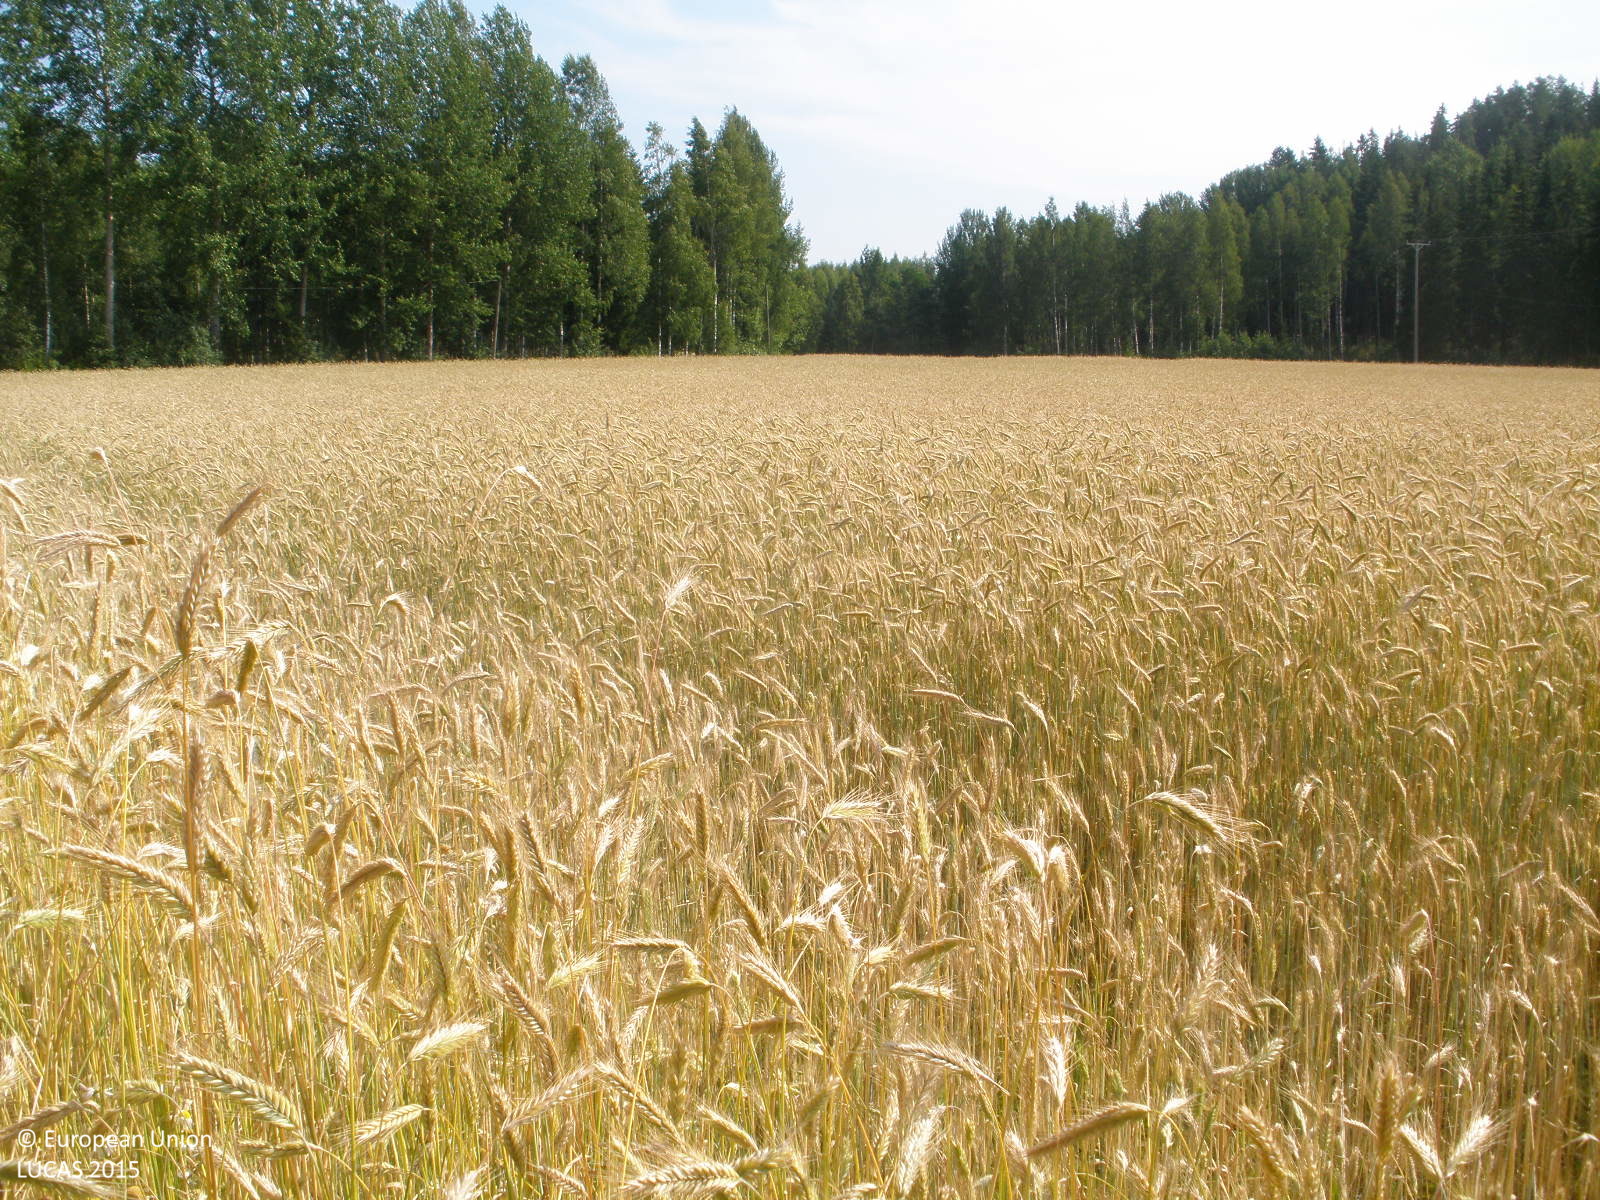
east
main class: Cropland
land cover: Common wheat
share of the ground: 50 - 75 %
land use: Agriculture (excluding fallow land and kitchen gardens)
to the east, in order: Common wheat; Spruce dominated mixed woodland
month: August
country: FI
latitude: 60.8558
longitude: 24.5171
